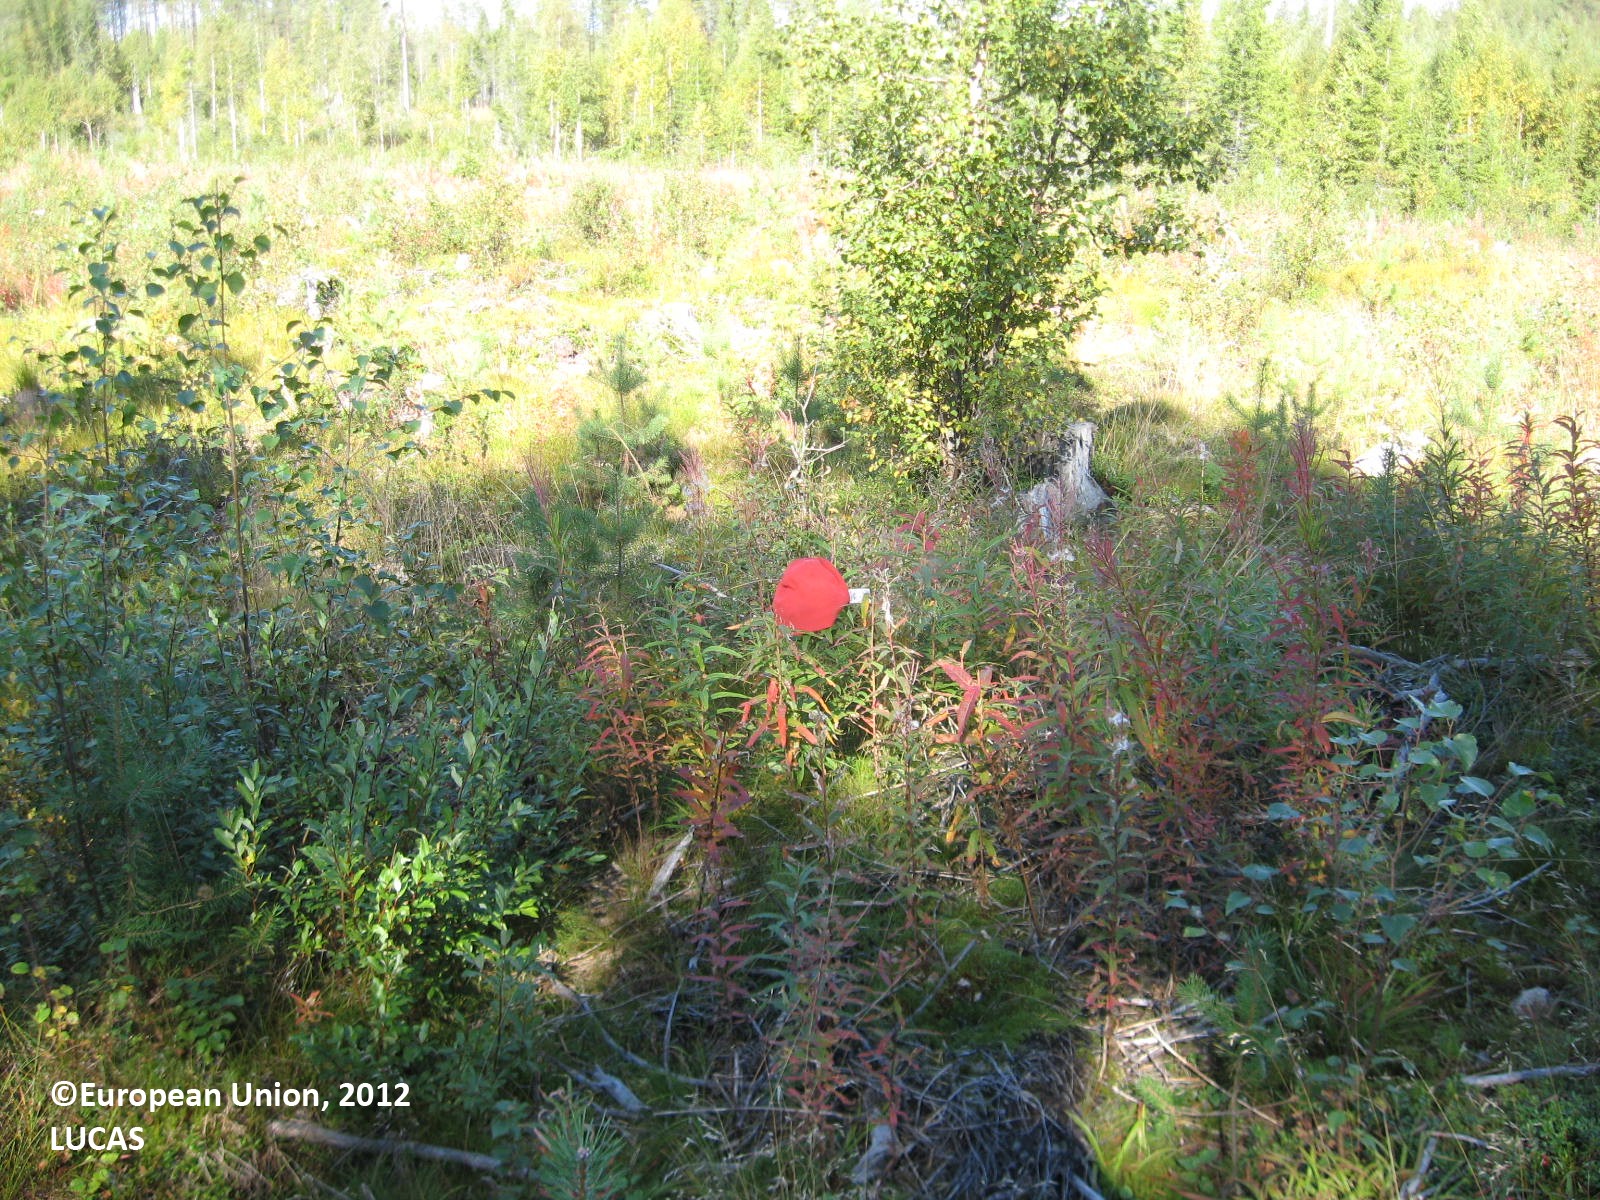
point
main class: Woodland
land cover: Other mixed woodland
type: boreal forest
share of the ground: 50 - 75 %
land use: Forestry
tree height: < 5 m
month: August
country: FI
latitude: 63.8345
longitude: 29.8514
